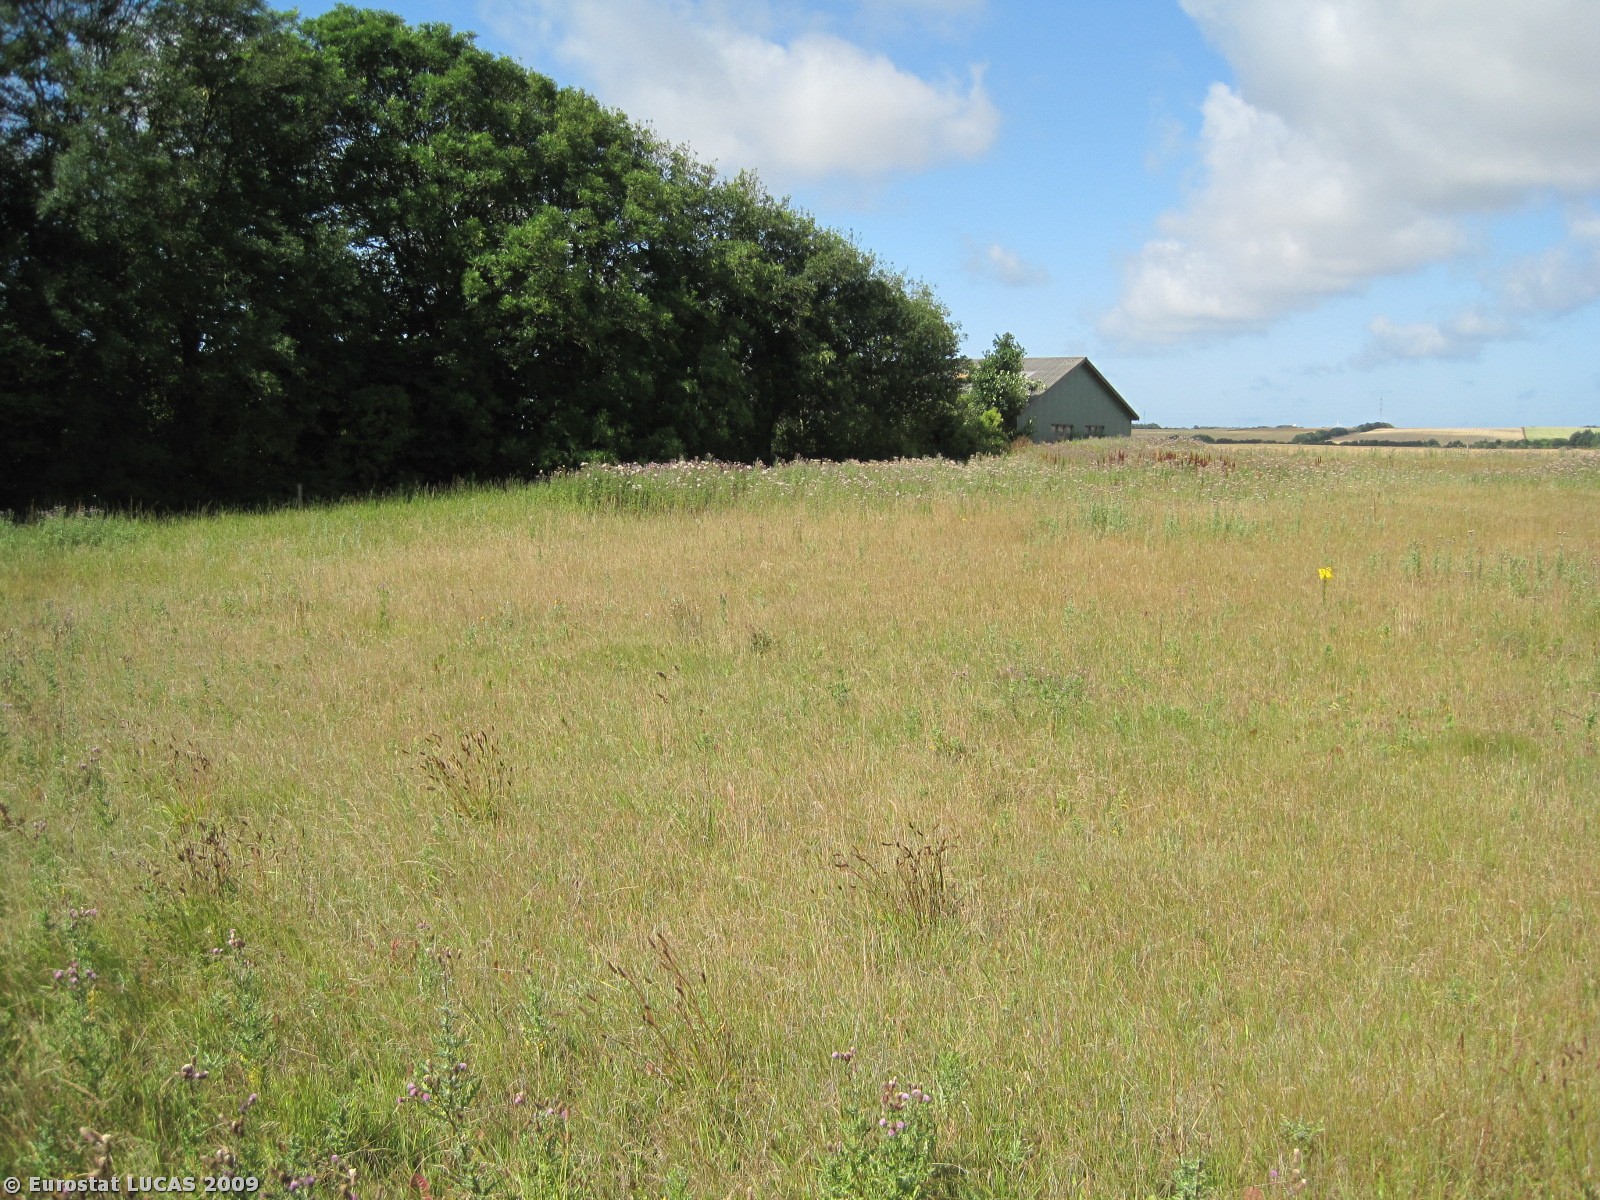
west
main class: Grassland
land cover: Grassland without tree/shrub cover
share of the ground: > 75 %
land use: Agriculture (excluding fallow land and kitchen gardens)
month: July
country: DK
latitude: 56.7174
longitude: 8.4172
